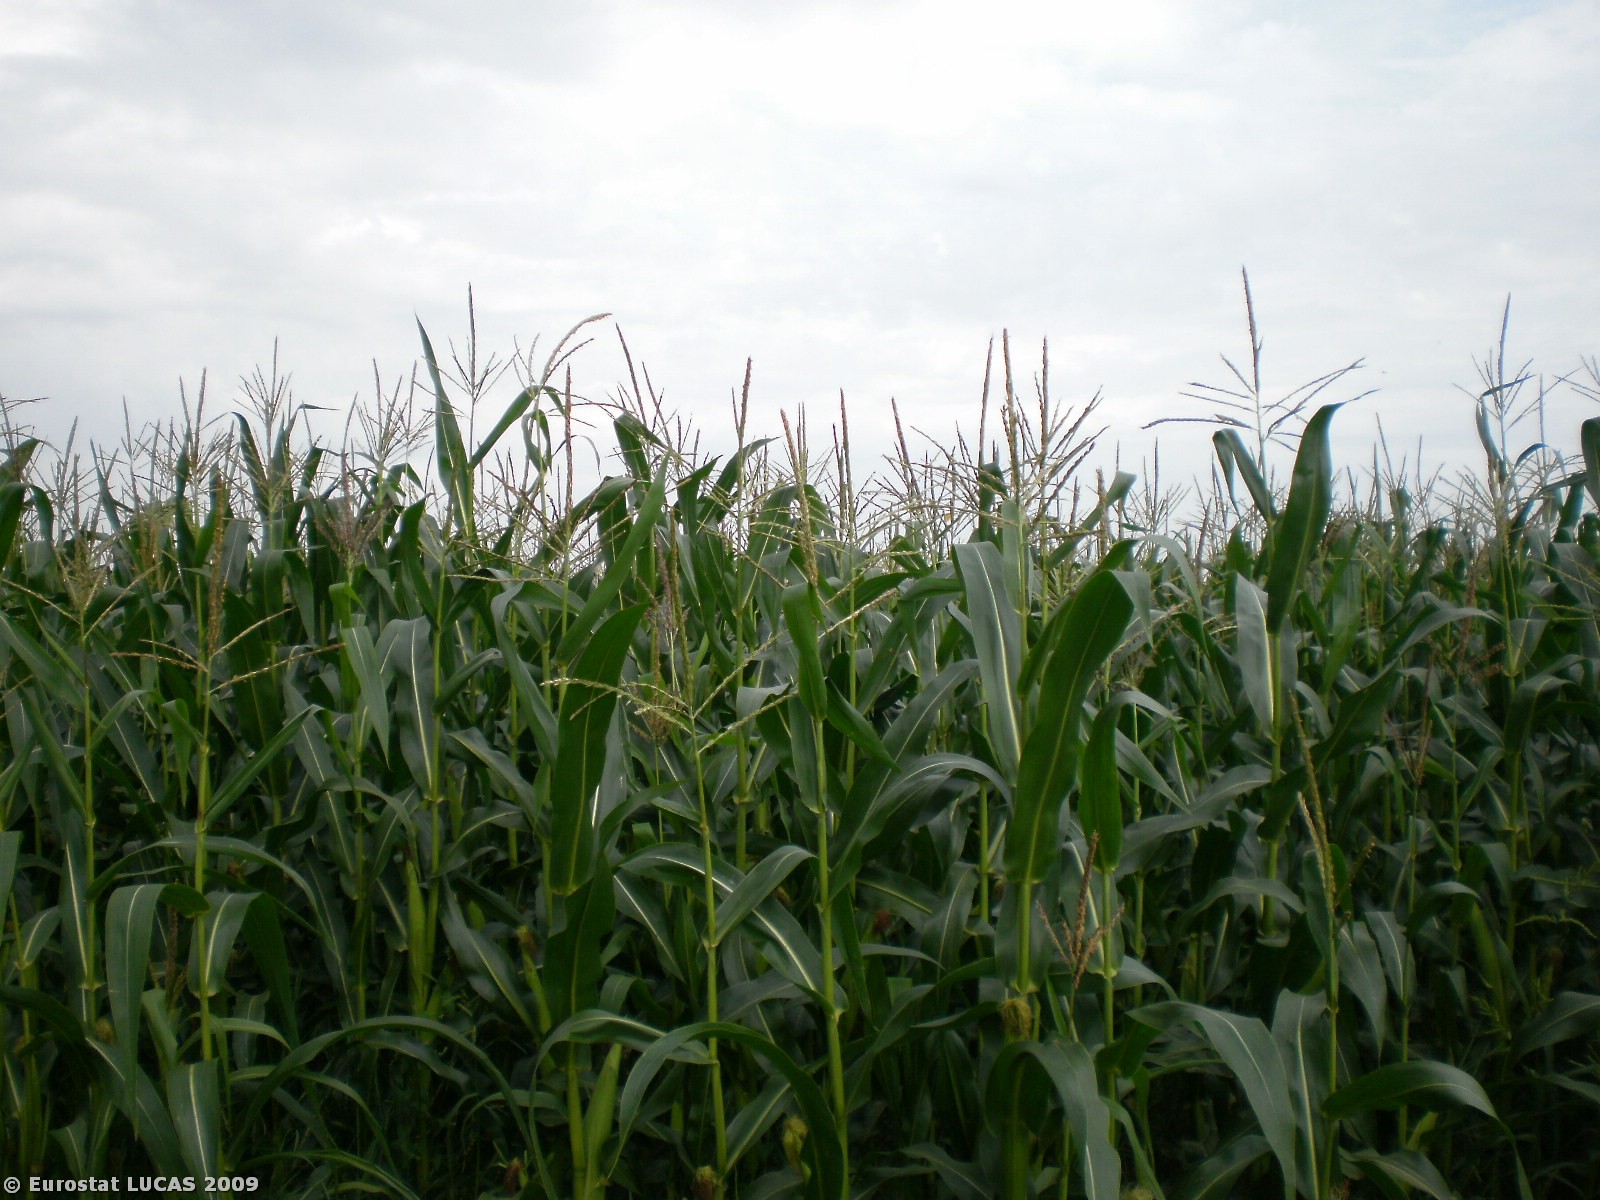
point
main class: Cropland
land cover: Maize
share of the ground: > 75 %
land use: Agriculture (excluding fallow land and kitchen gardens)
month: August
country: PL
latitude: 53.0179
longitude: 21.8469
